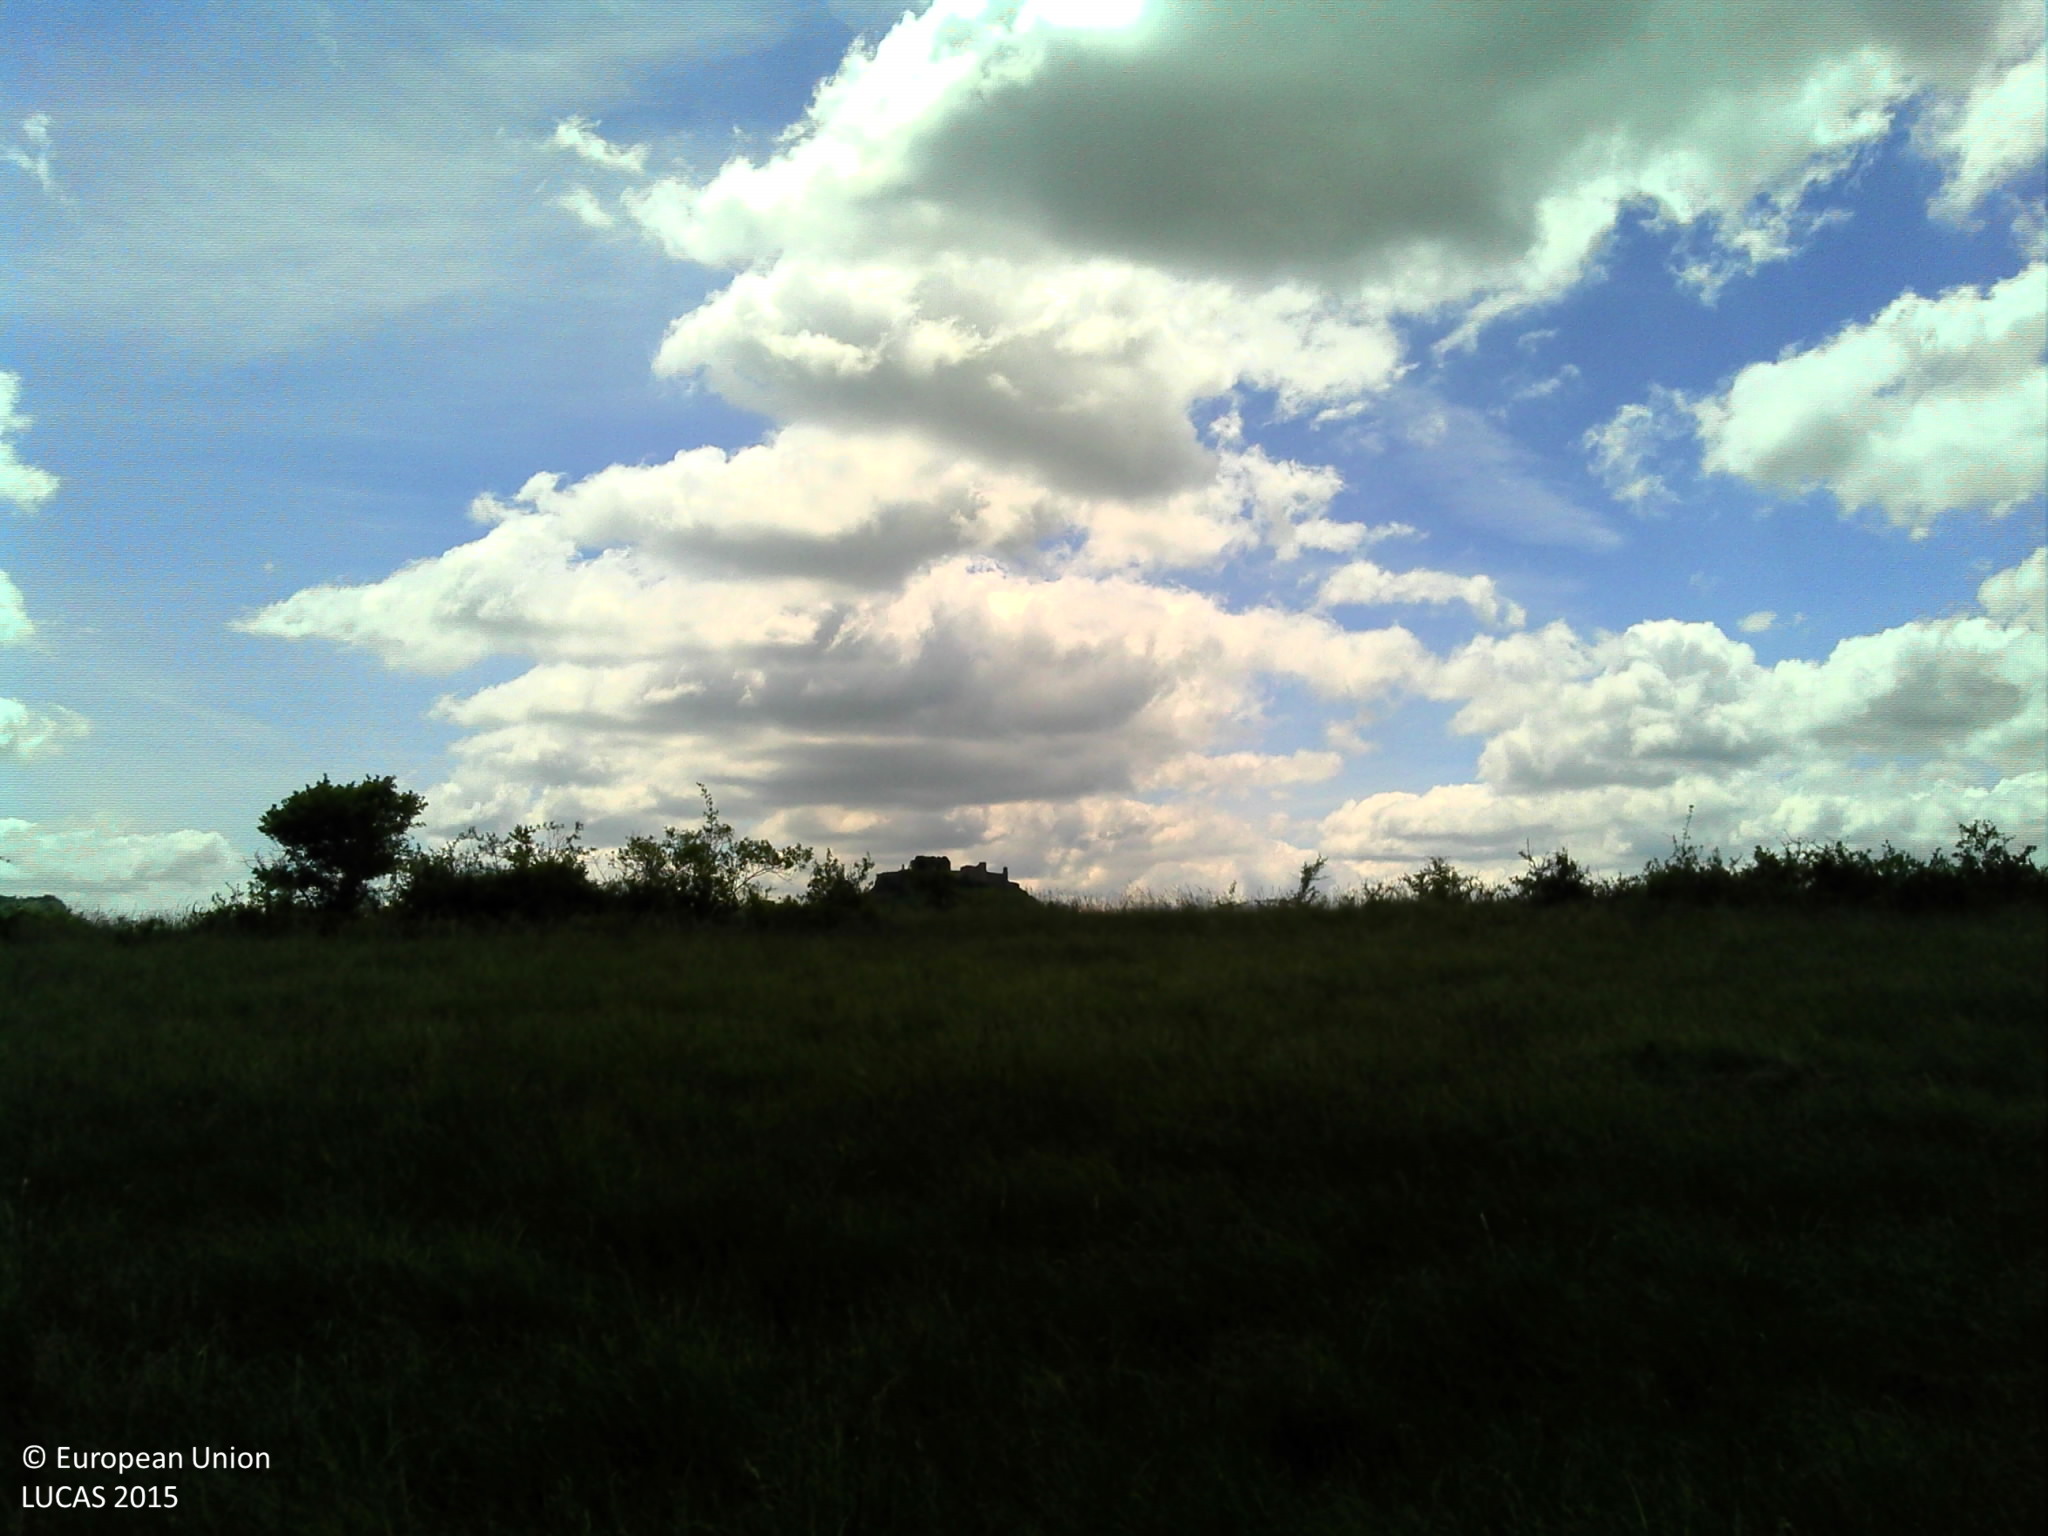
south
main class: Grassland
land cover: Grassland with sparse tree/shrub cover
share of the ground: > 75 %
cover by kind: herbaceous plants 85 %, shrubs 10 %, coniferous forest trees 5 %
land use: Agriculture (excluding fallow land and kitchen gardens)
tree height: < 5 m
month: May
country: FR
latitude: 44.3359
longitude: 3.0693
